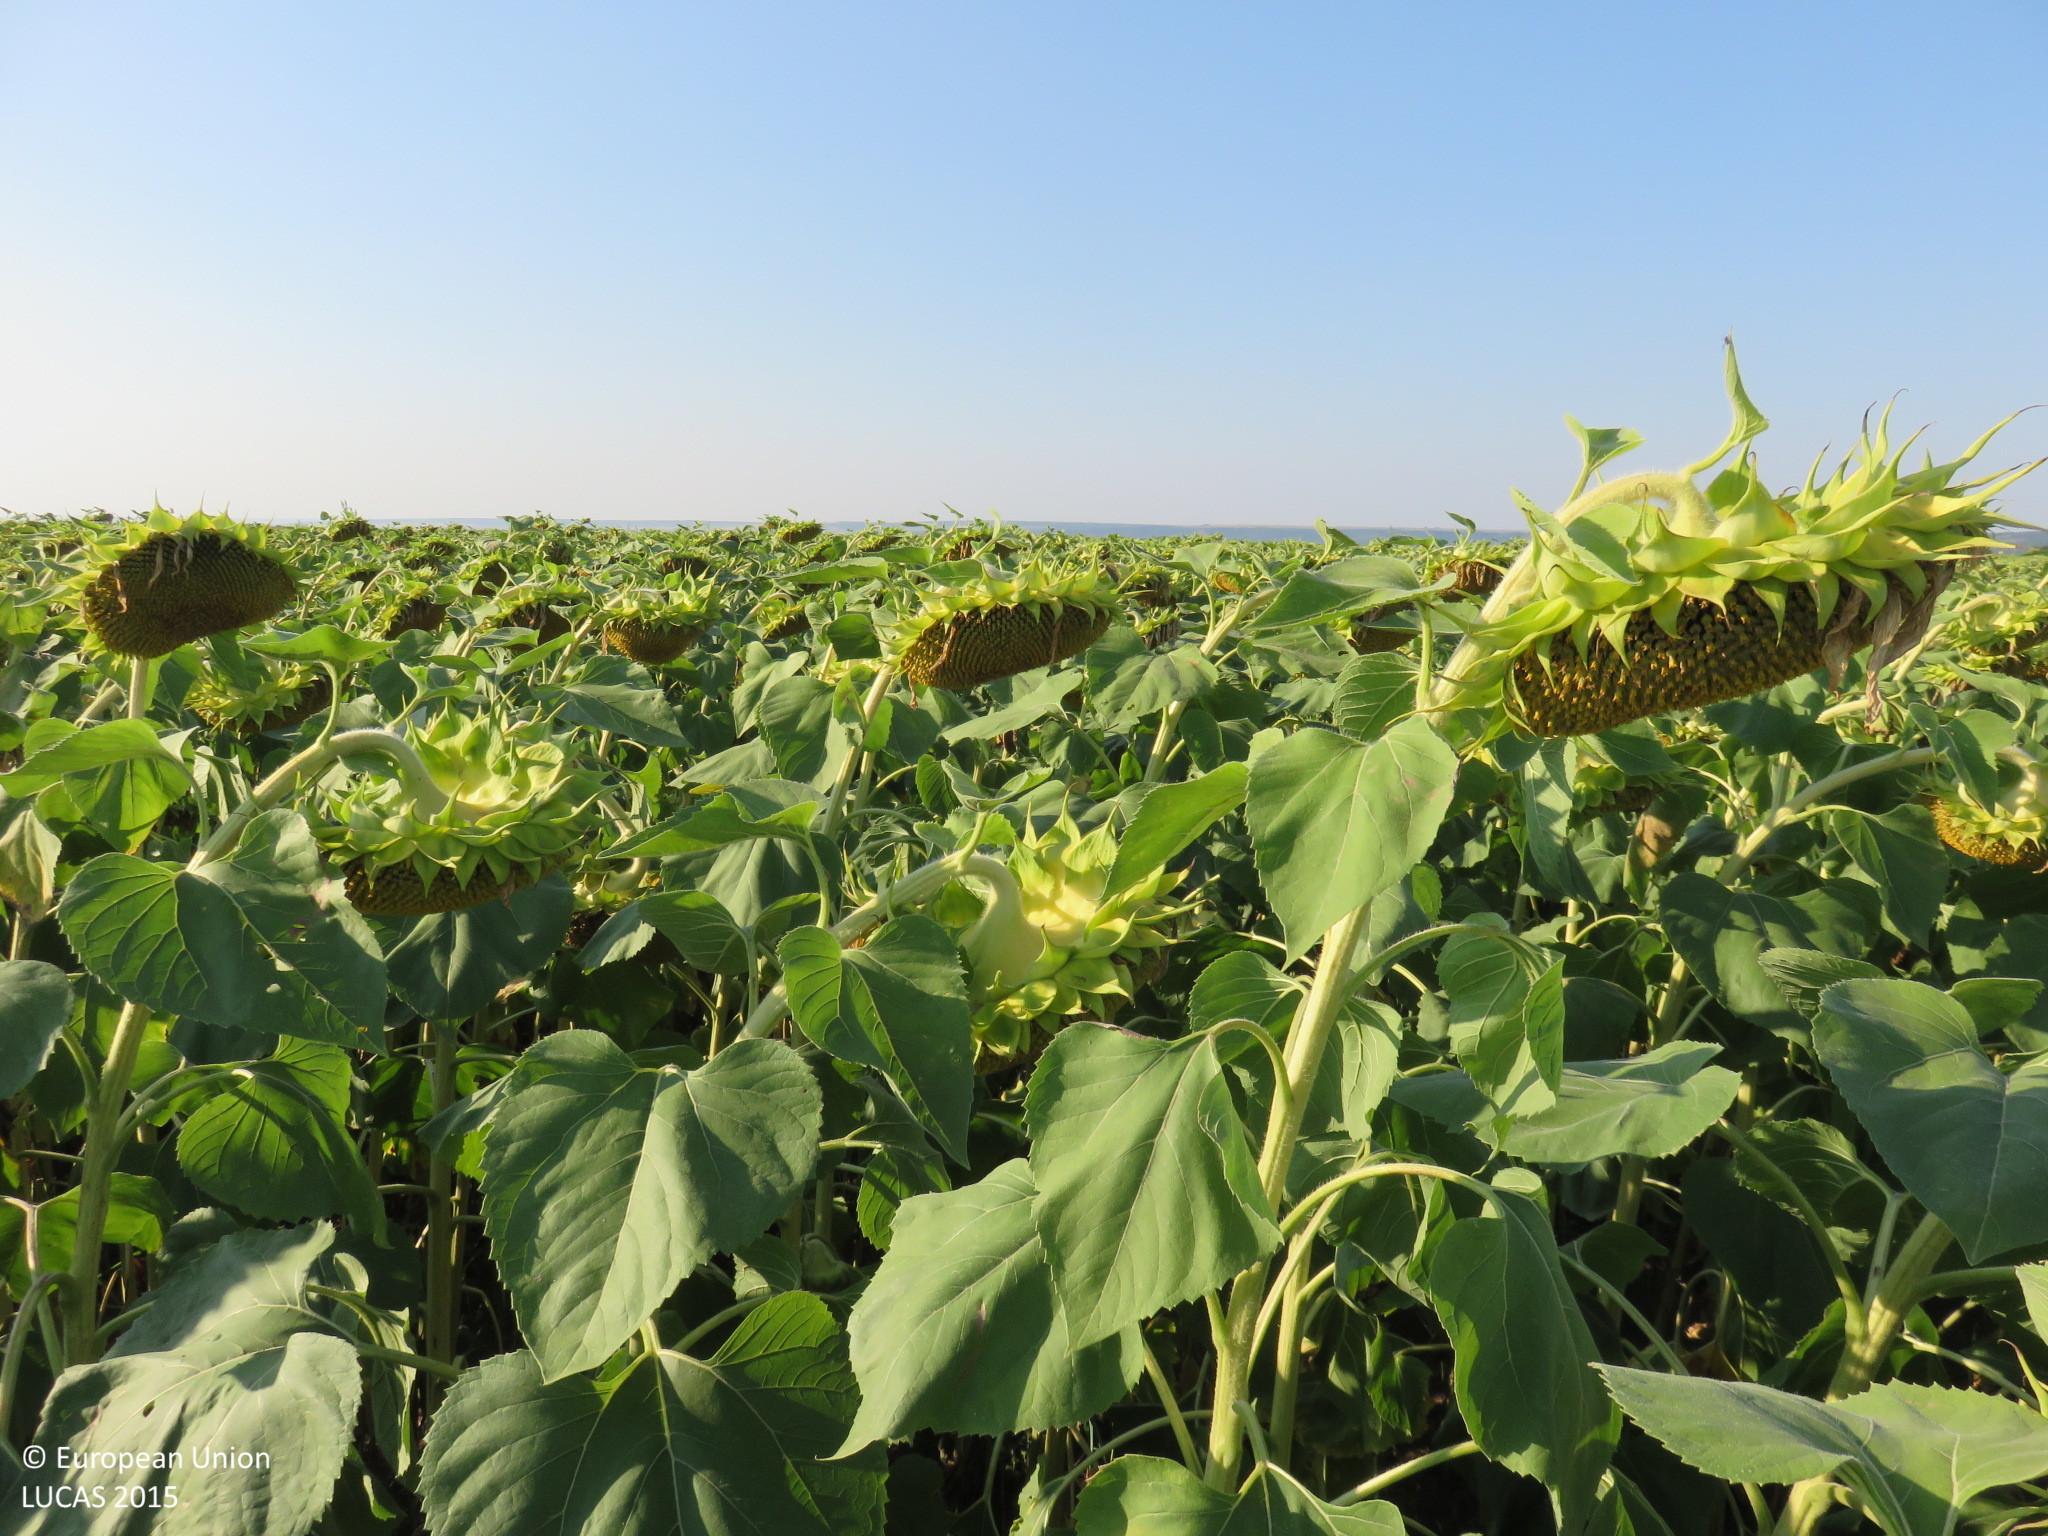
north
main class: Cropland
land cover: Sunflower
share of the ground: > 75 %
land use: Agriculture (excluding fallow land and kitchen gardens)
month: July
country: BG
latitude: 43.3854
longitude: 25.0947
